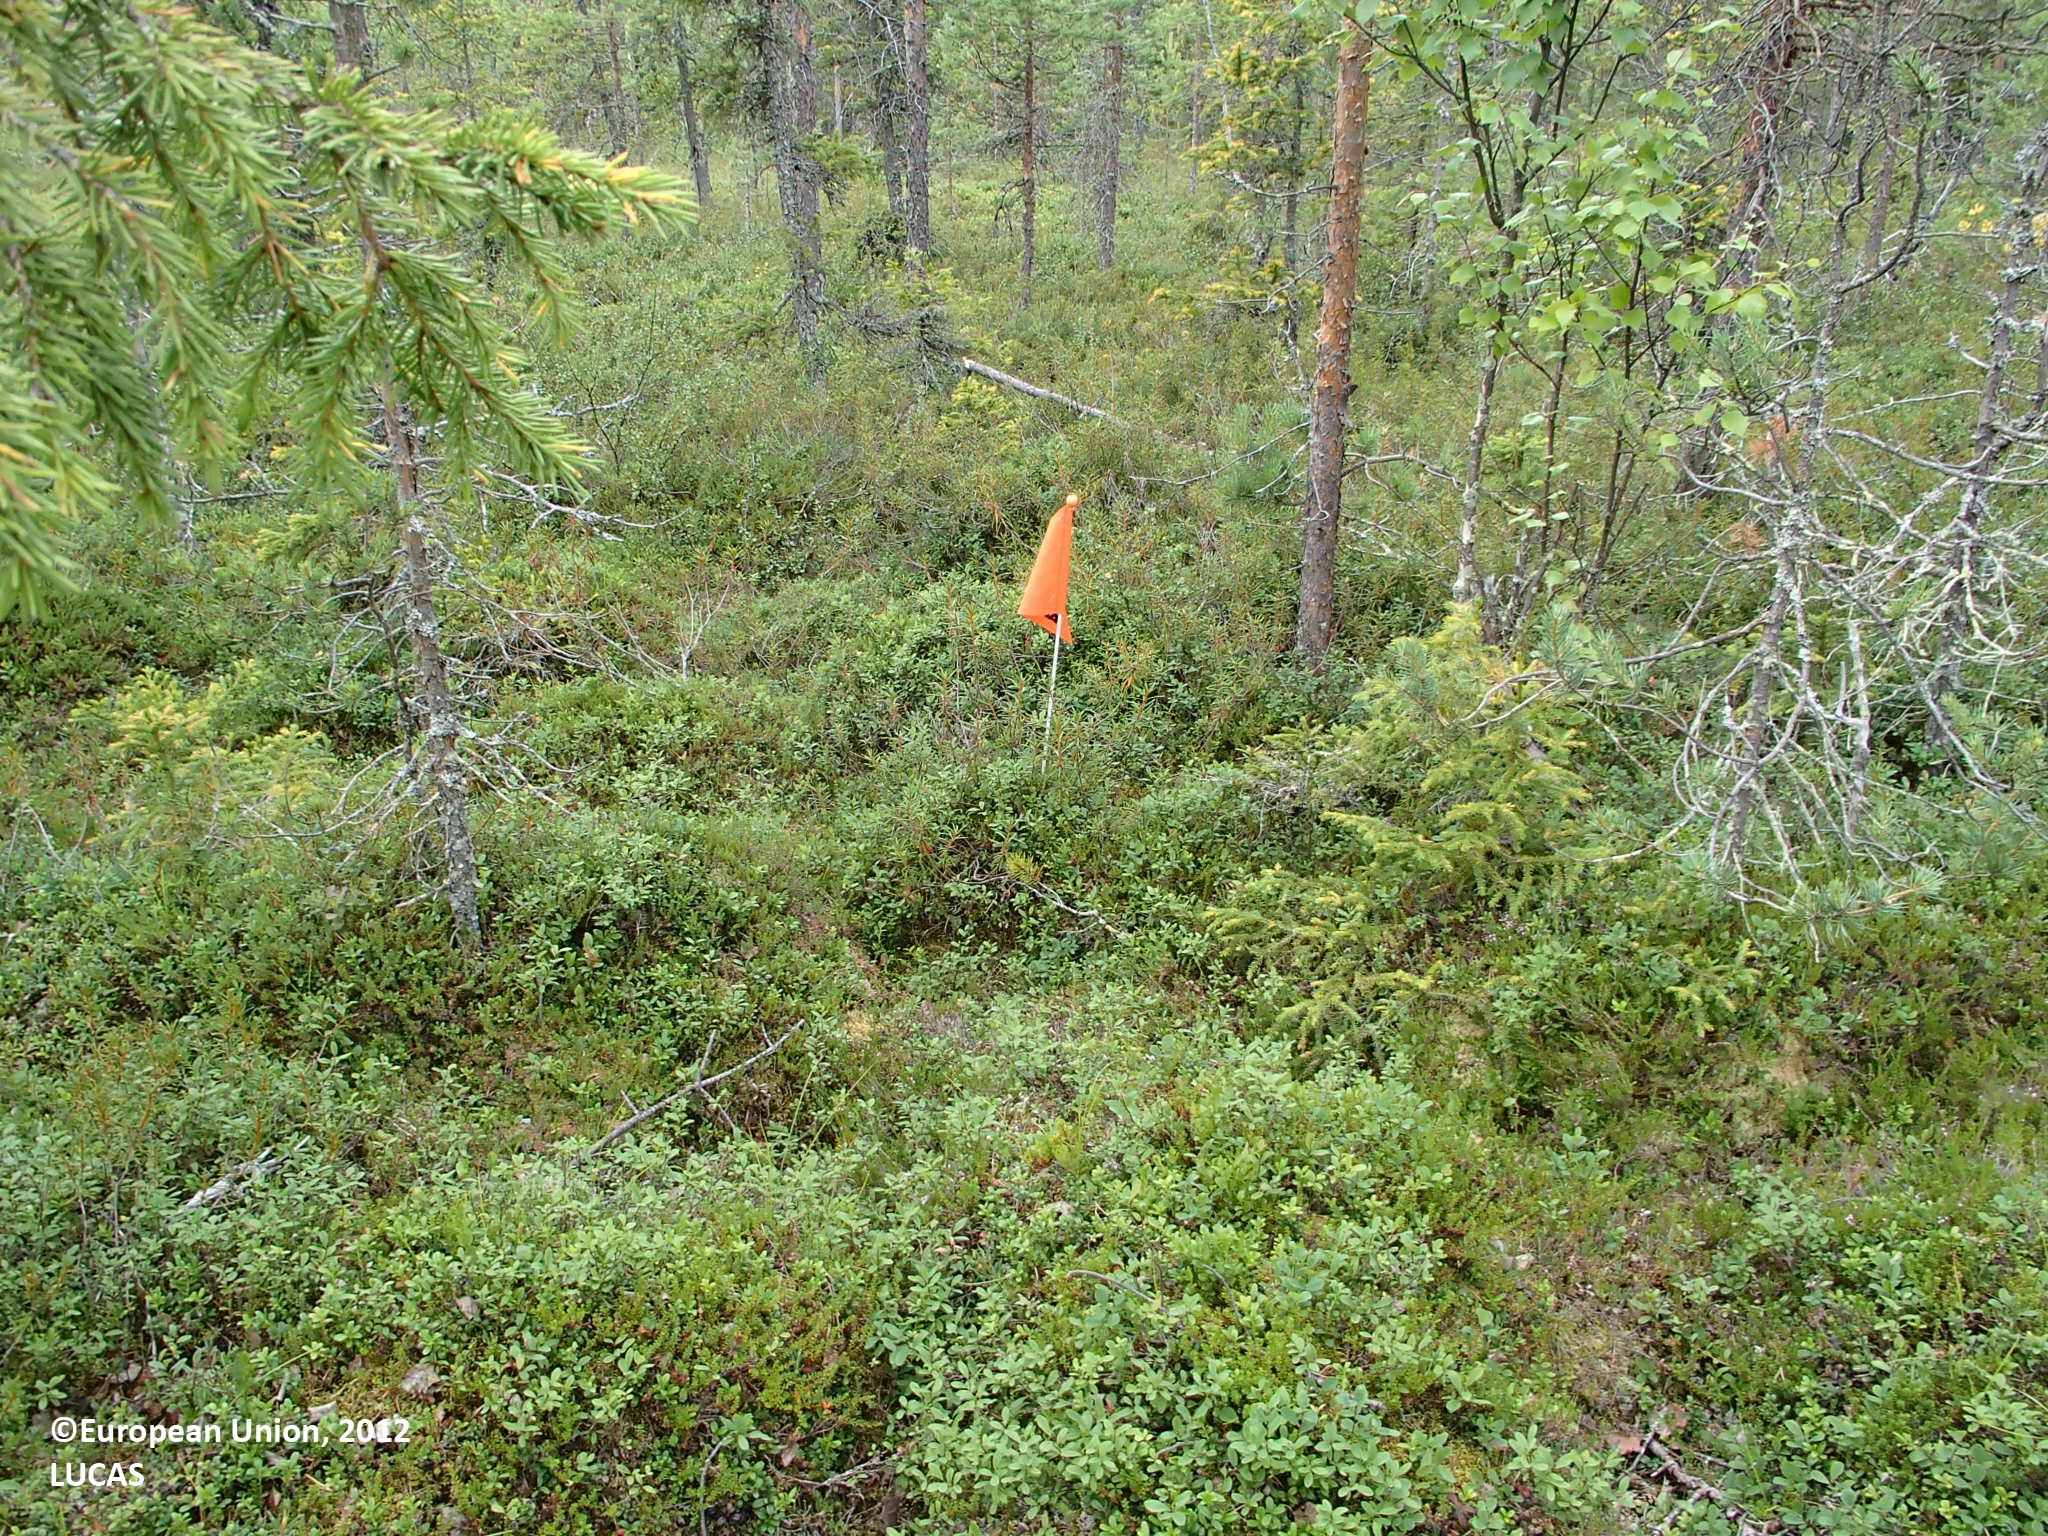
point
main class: Woodland
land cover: Other coniferous woodland
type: boreal forest
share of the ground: 50 - 75 %
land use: Forestry
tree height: > 5 m
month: July
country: FI
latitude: 66.1614
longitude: 25.3428
